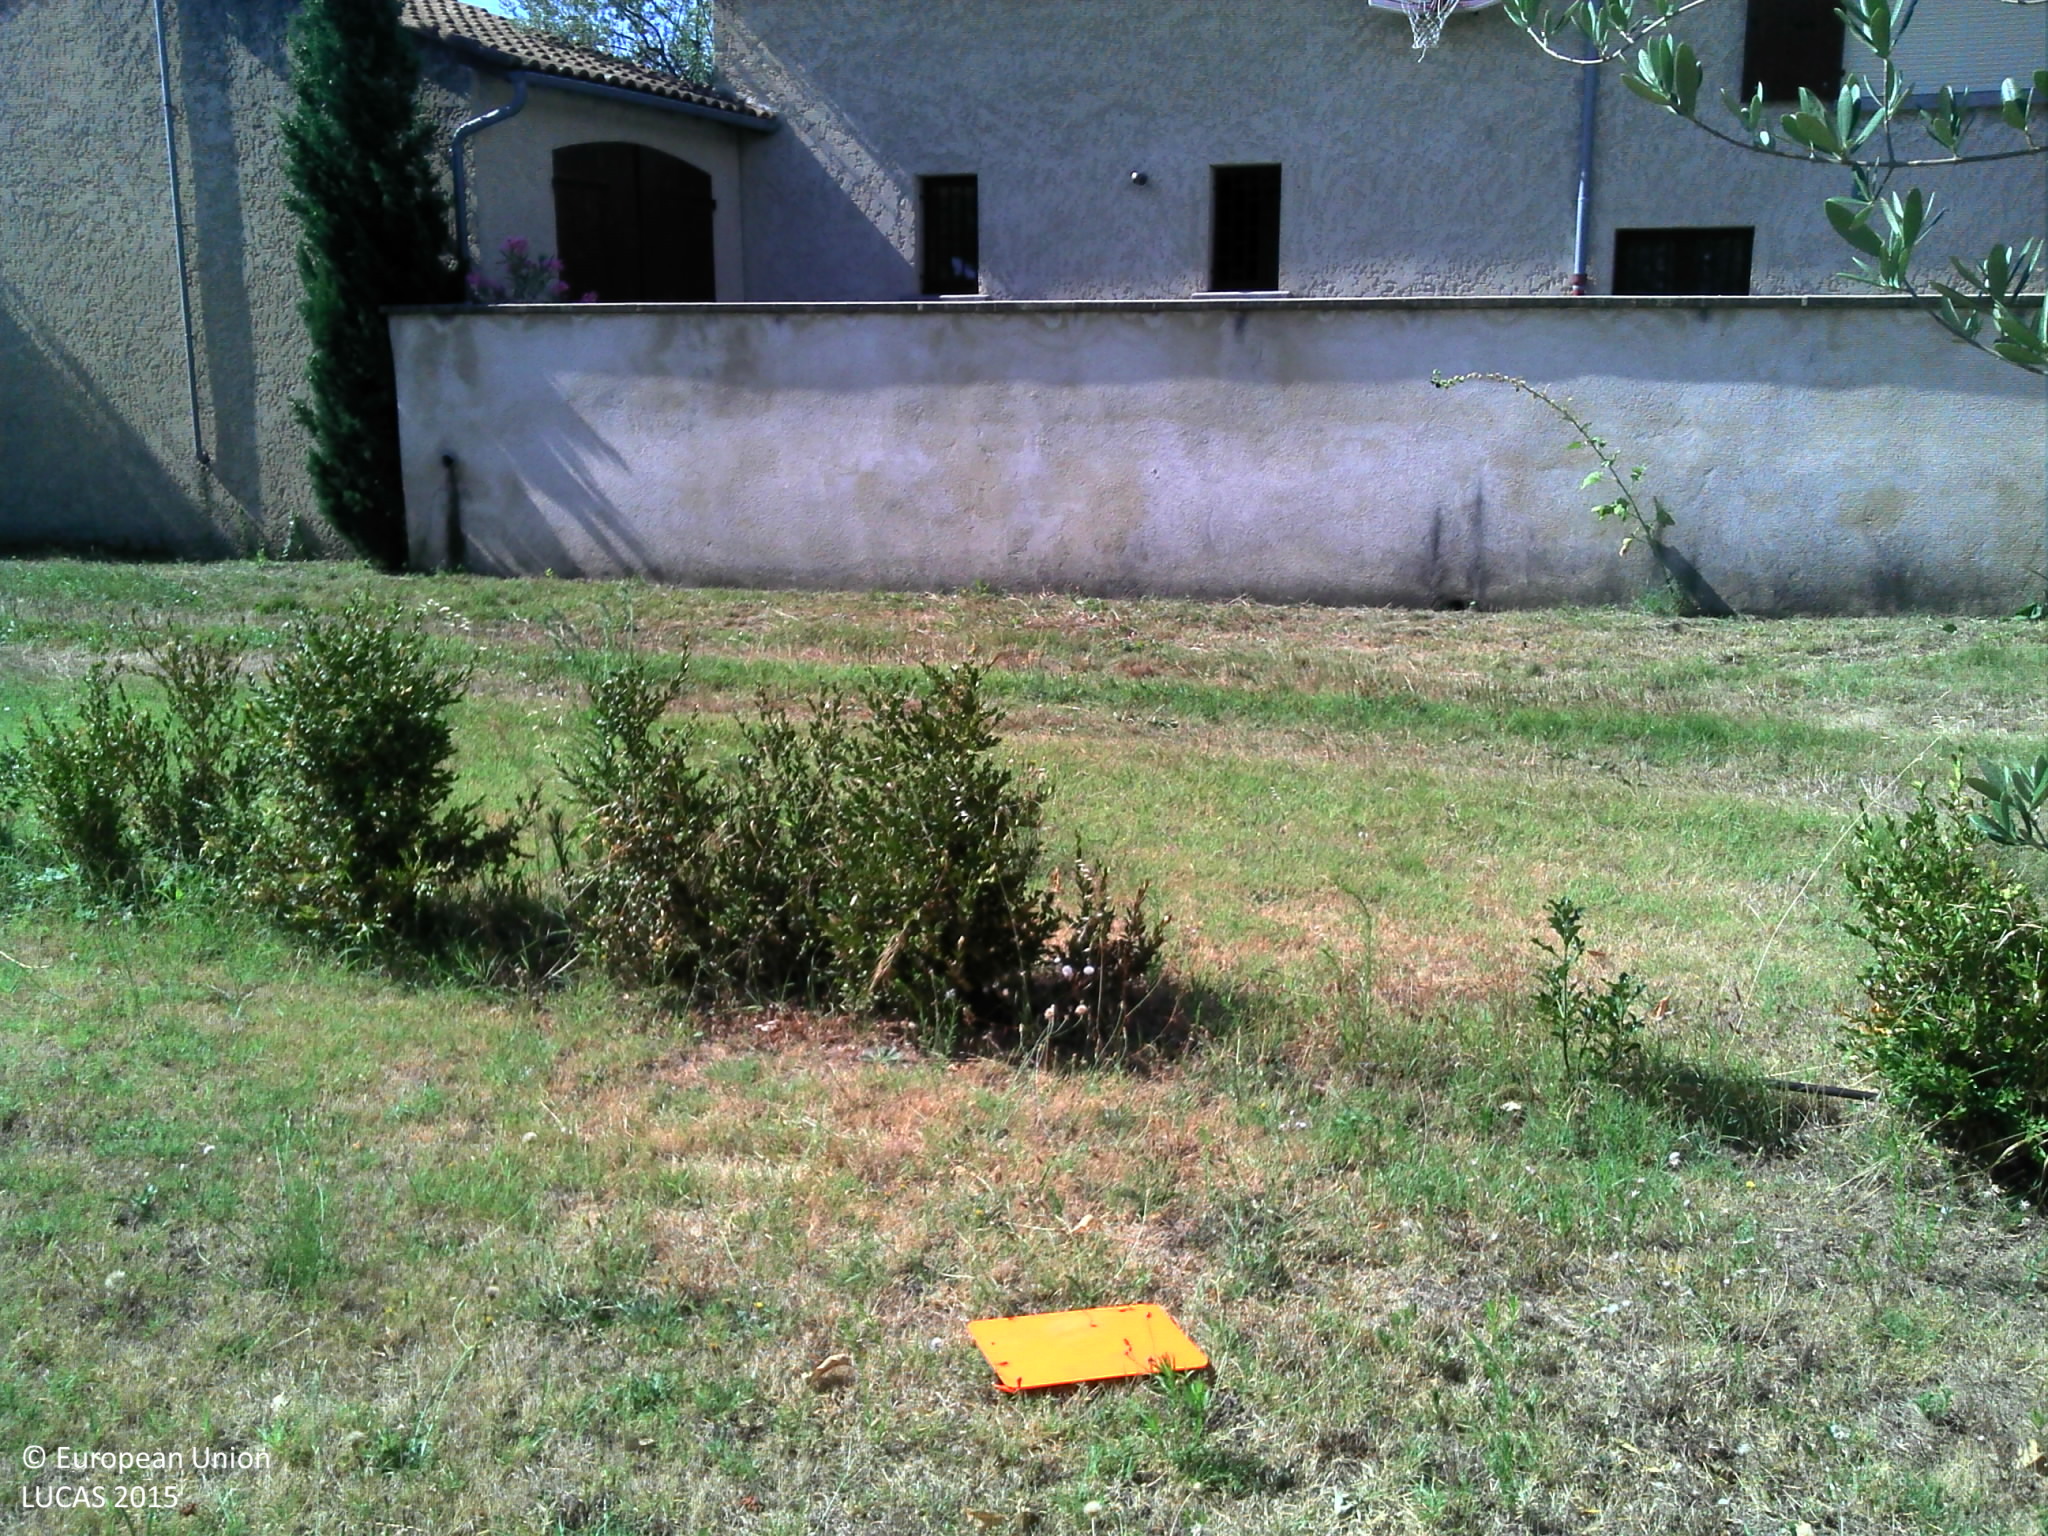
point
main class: Grassland
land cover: Grassland with sparse tree/shrub cover
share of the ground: > 75 %
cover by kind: herbaceous plants 95 %, broadleaved forest trees 5 %
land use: Residential
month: July
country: FR
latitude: 44.7976
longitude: 4.7851
